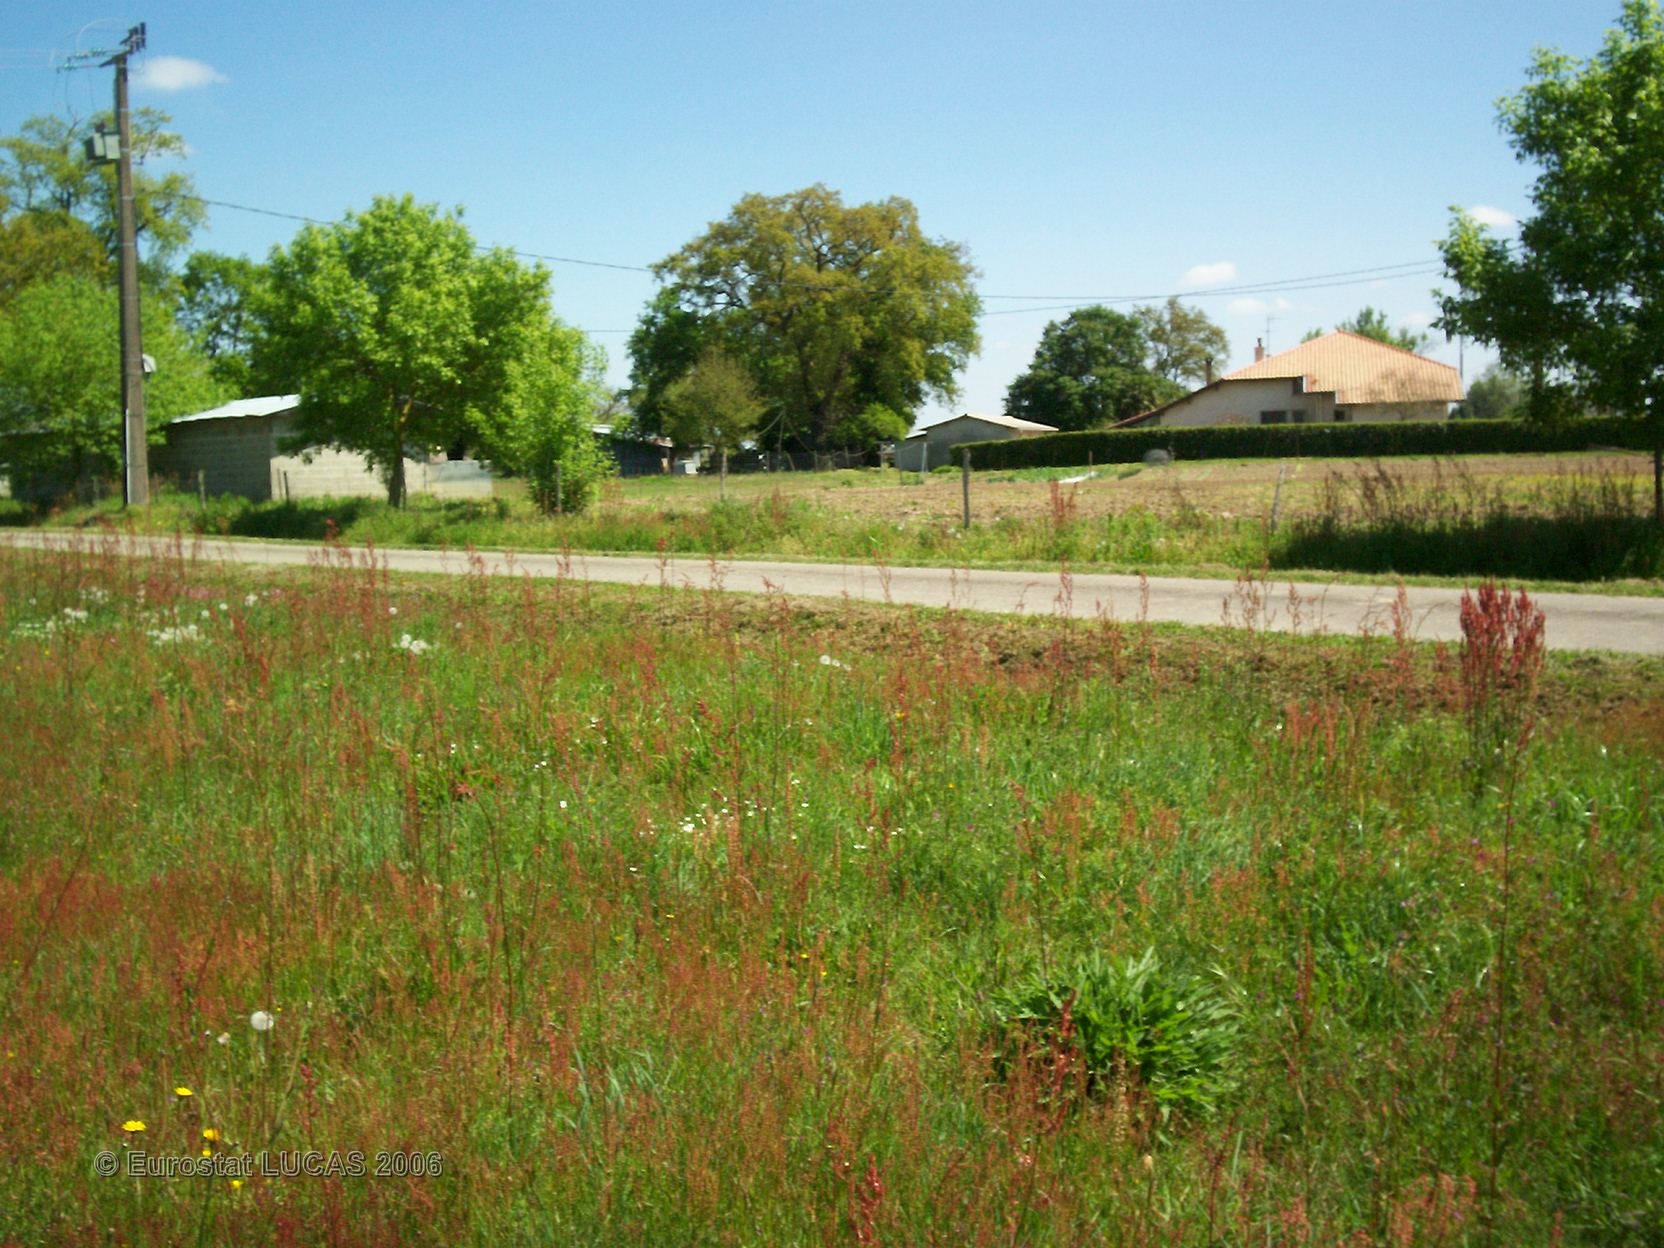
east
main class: Grassland
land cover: Grassland without tree/shrub cover
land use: Agriculture (excluding fallow land and kitchen gardens)
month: April
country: FR
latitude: 43.7765
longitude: -0.7103
